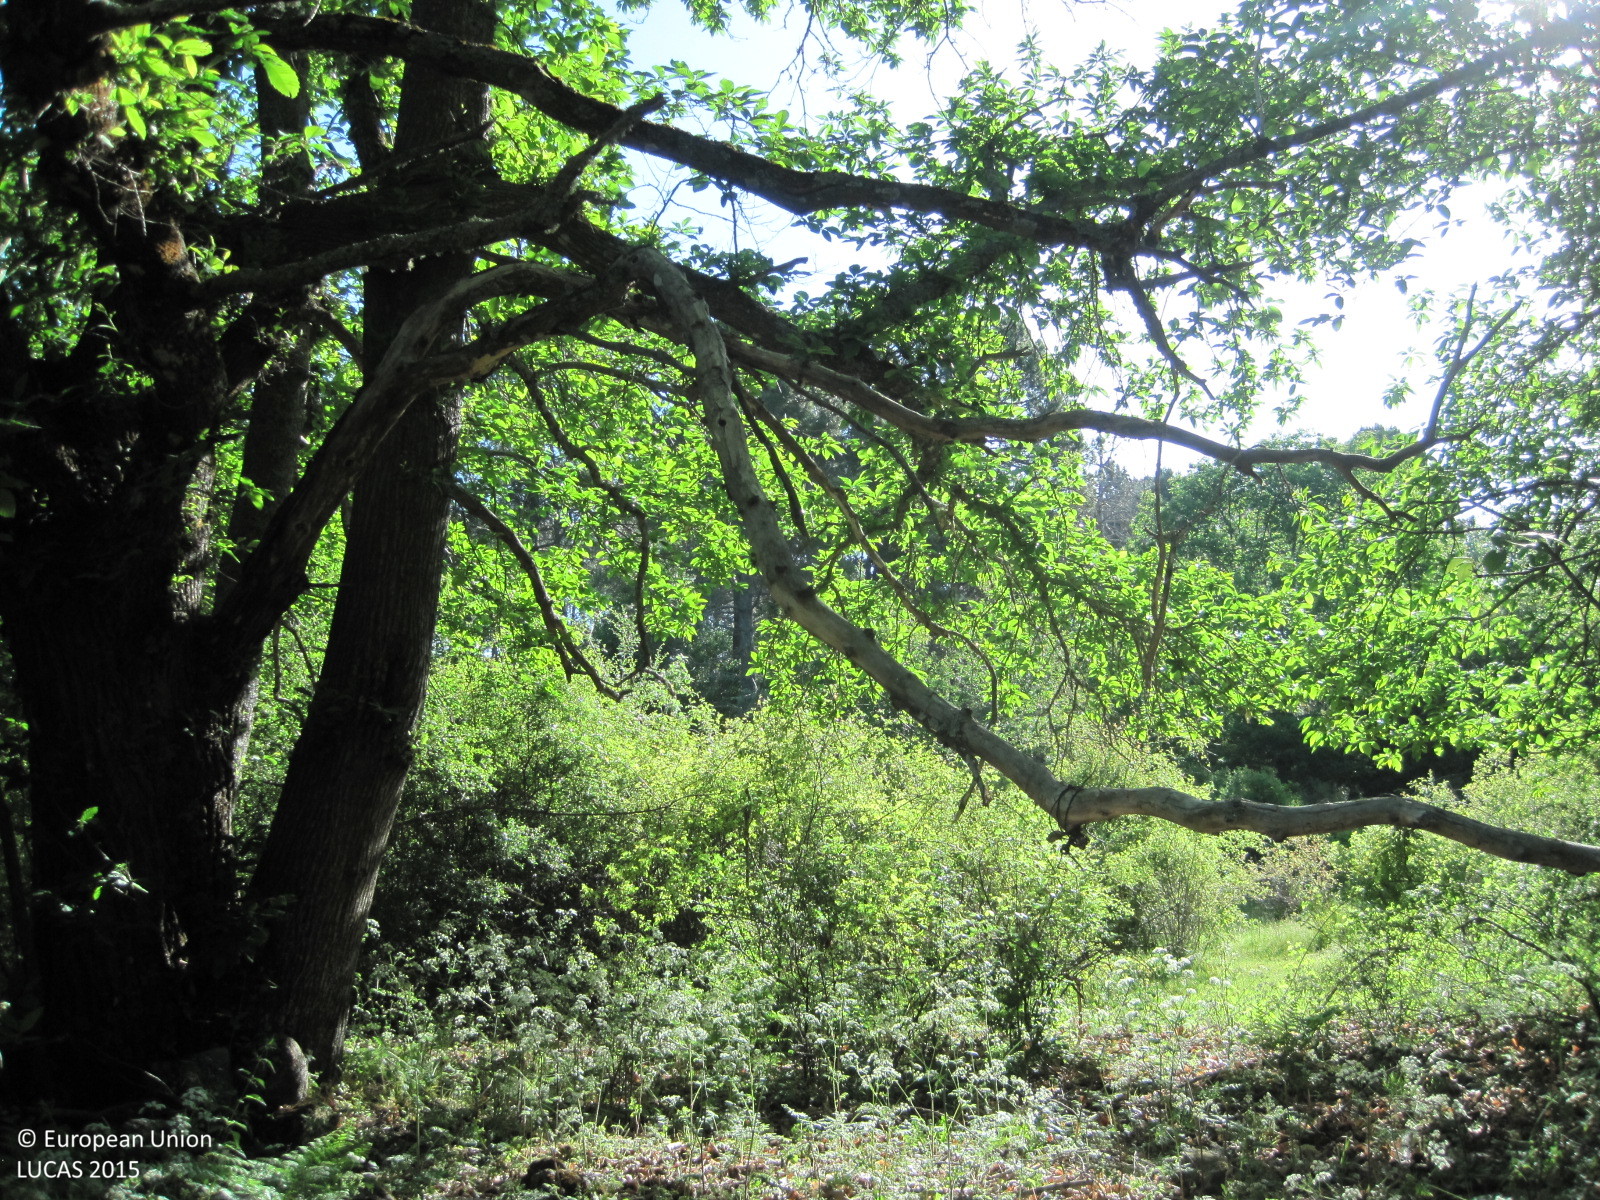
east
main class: Grassland
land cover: Grassland without tree/shrub cover
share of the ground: > 75 %
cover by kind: herbaceous plants 100 %
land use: Agriculture (excluding fallow land and kitchen gardens)
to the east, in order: Grassland without tree/shrub cover; Pine dominated coniferous woodland; Grassland without tree/shrub cover; Pine dominated mixed woodland; Fences; Pine dominated mixed woodland; Dry stone walls; Shrubland with sparse tree cover
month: May
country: ES
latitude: 40.1395
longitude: -4.7320
